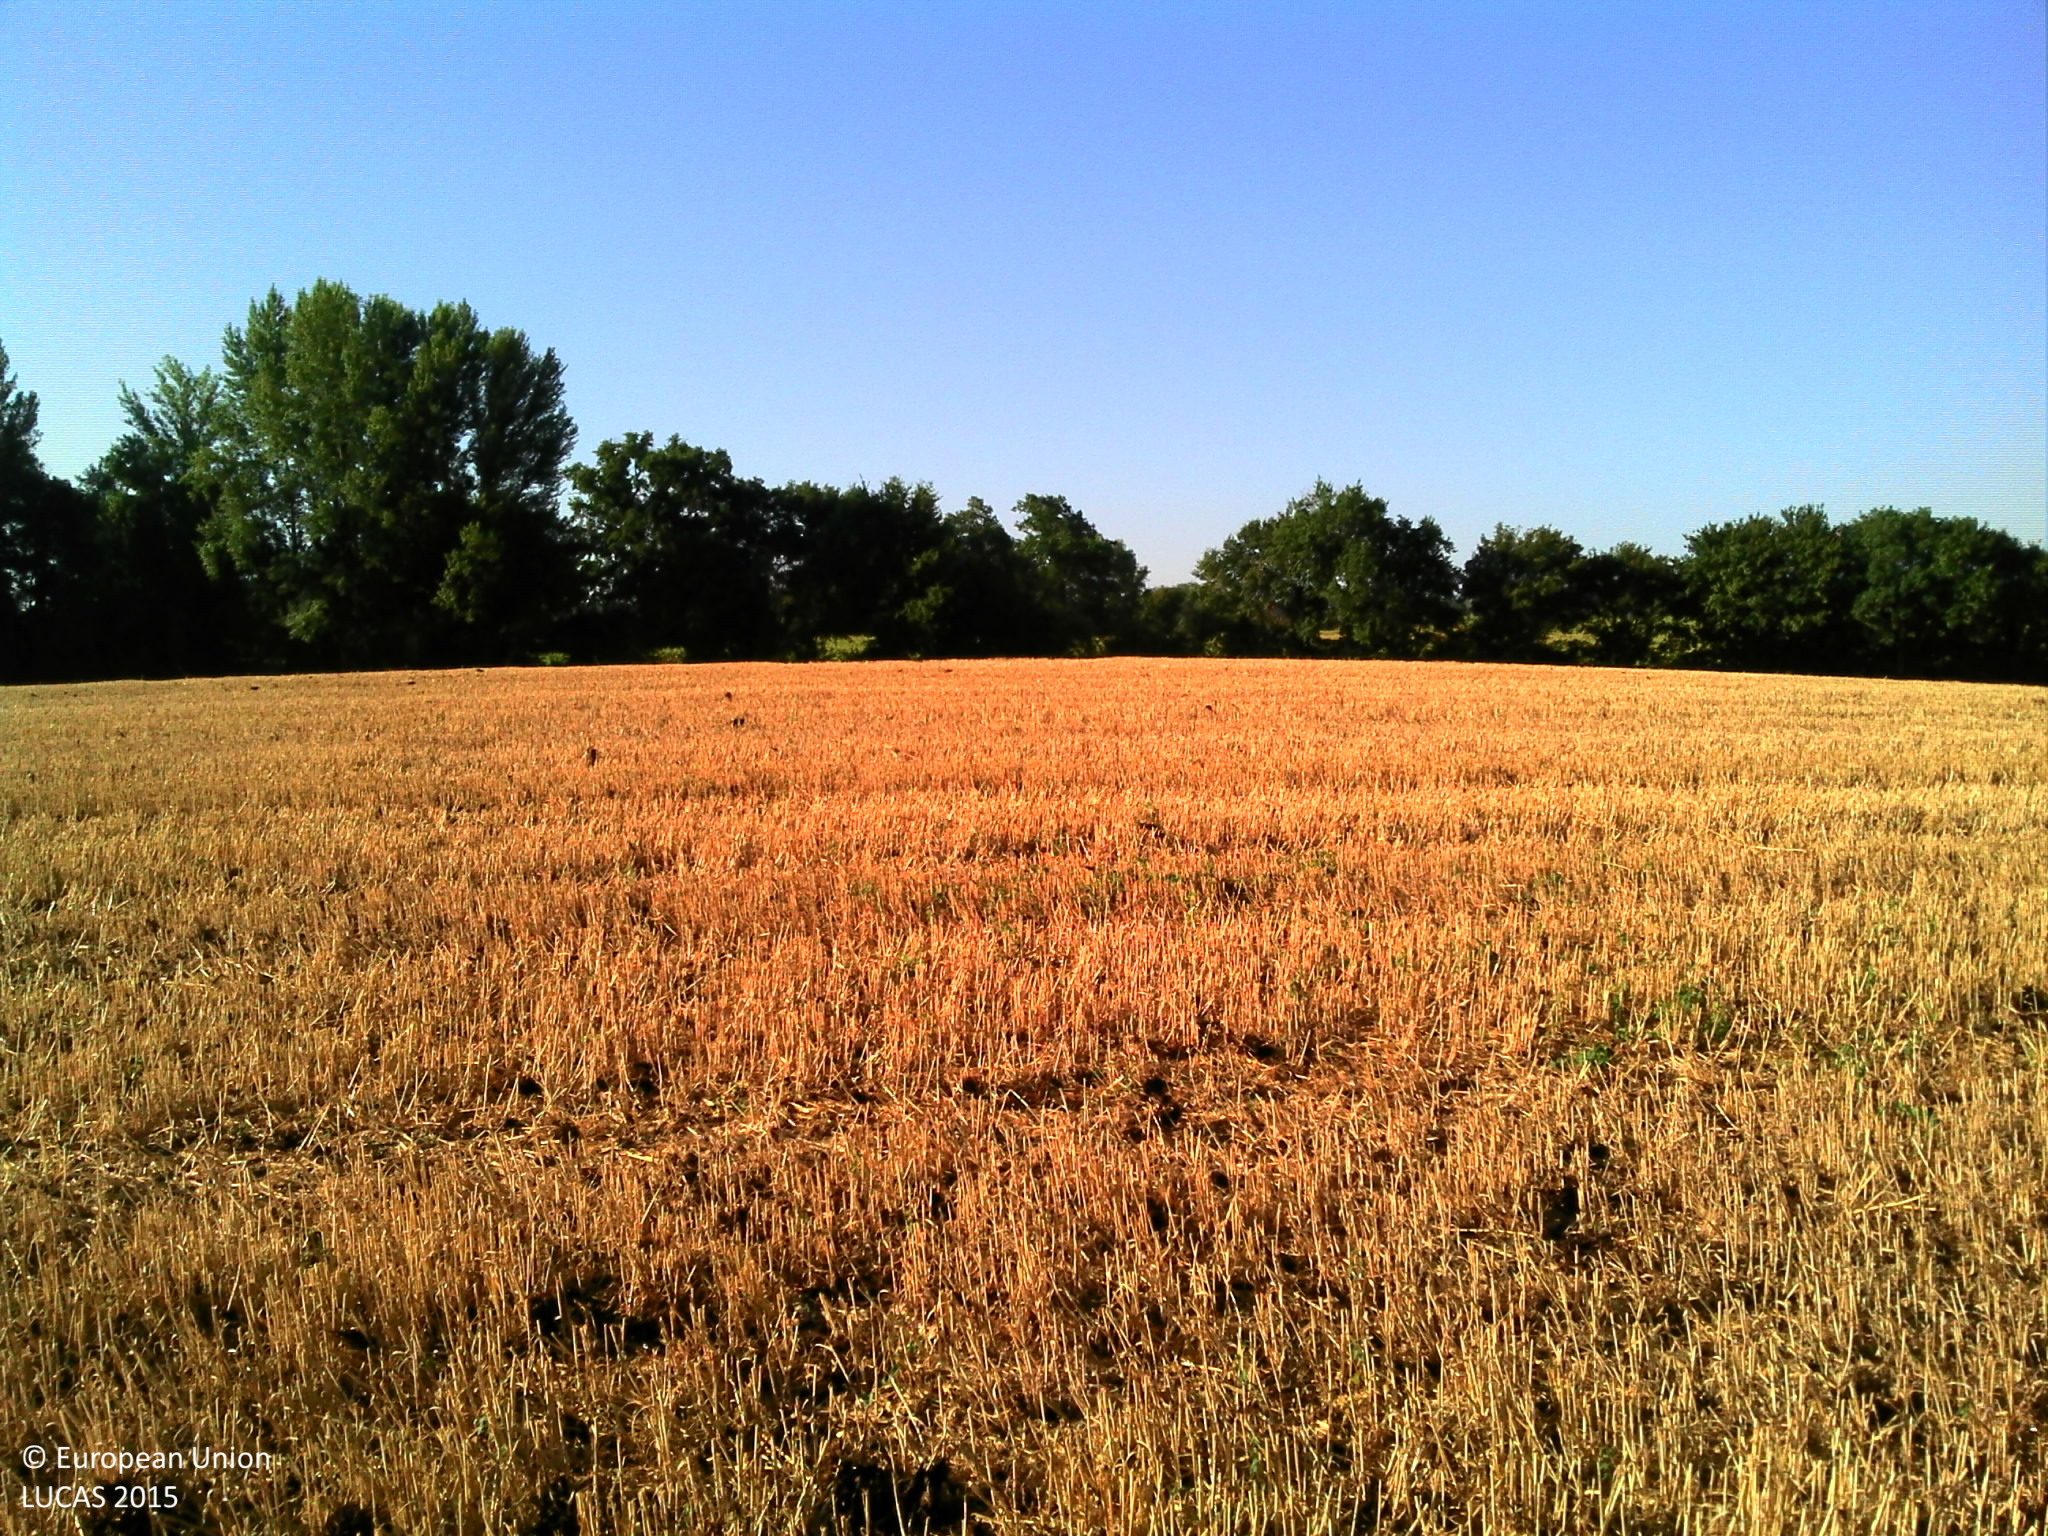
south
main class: Cropland
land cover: Common wheat
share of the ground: > 75 %
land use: Agriculture (excluding fallow land and kitchen gardens)
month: July
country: FR
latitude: 44.5951
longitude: 0.6073
